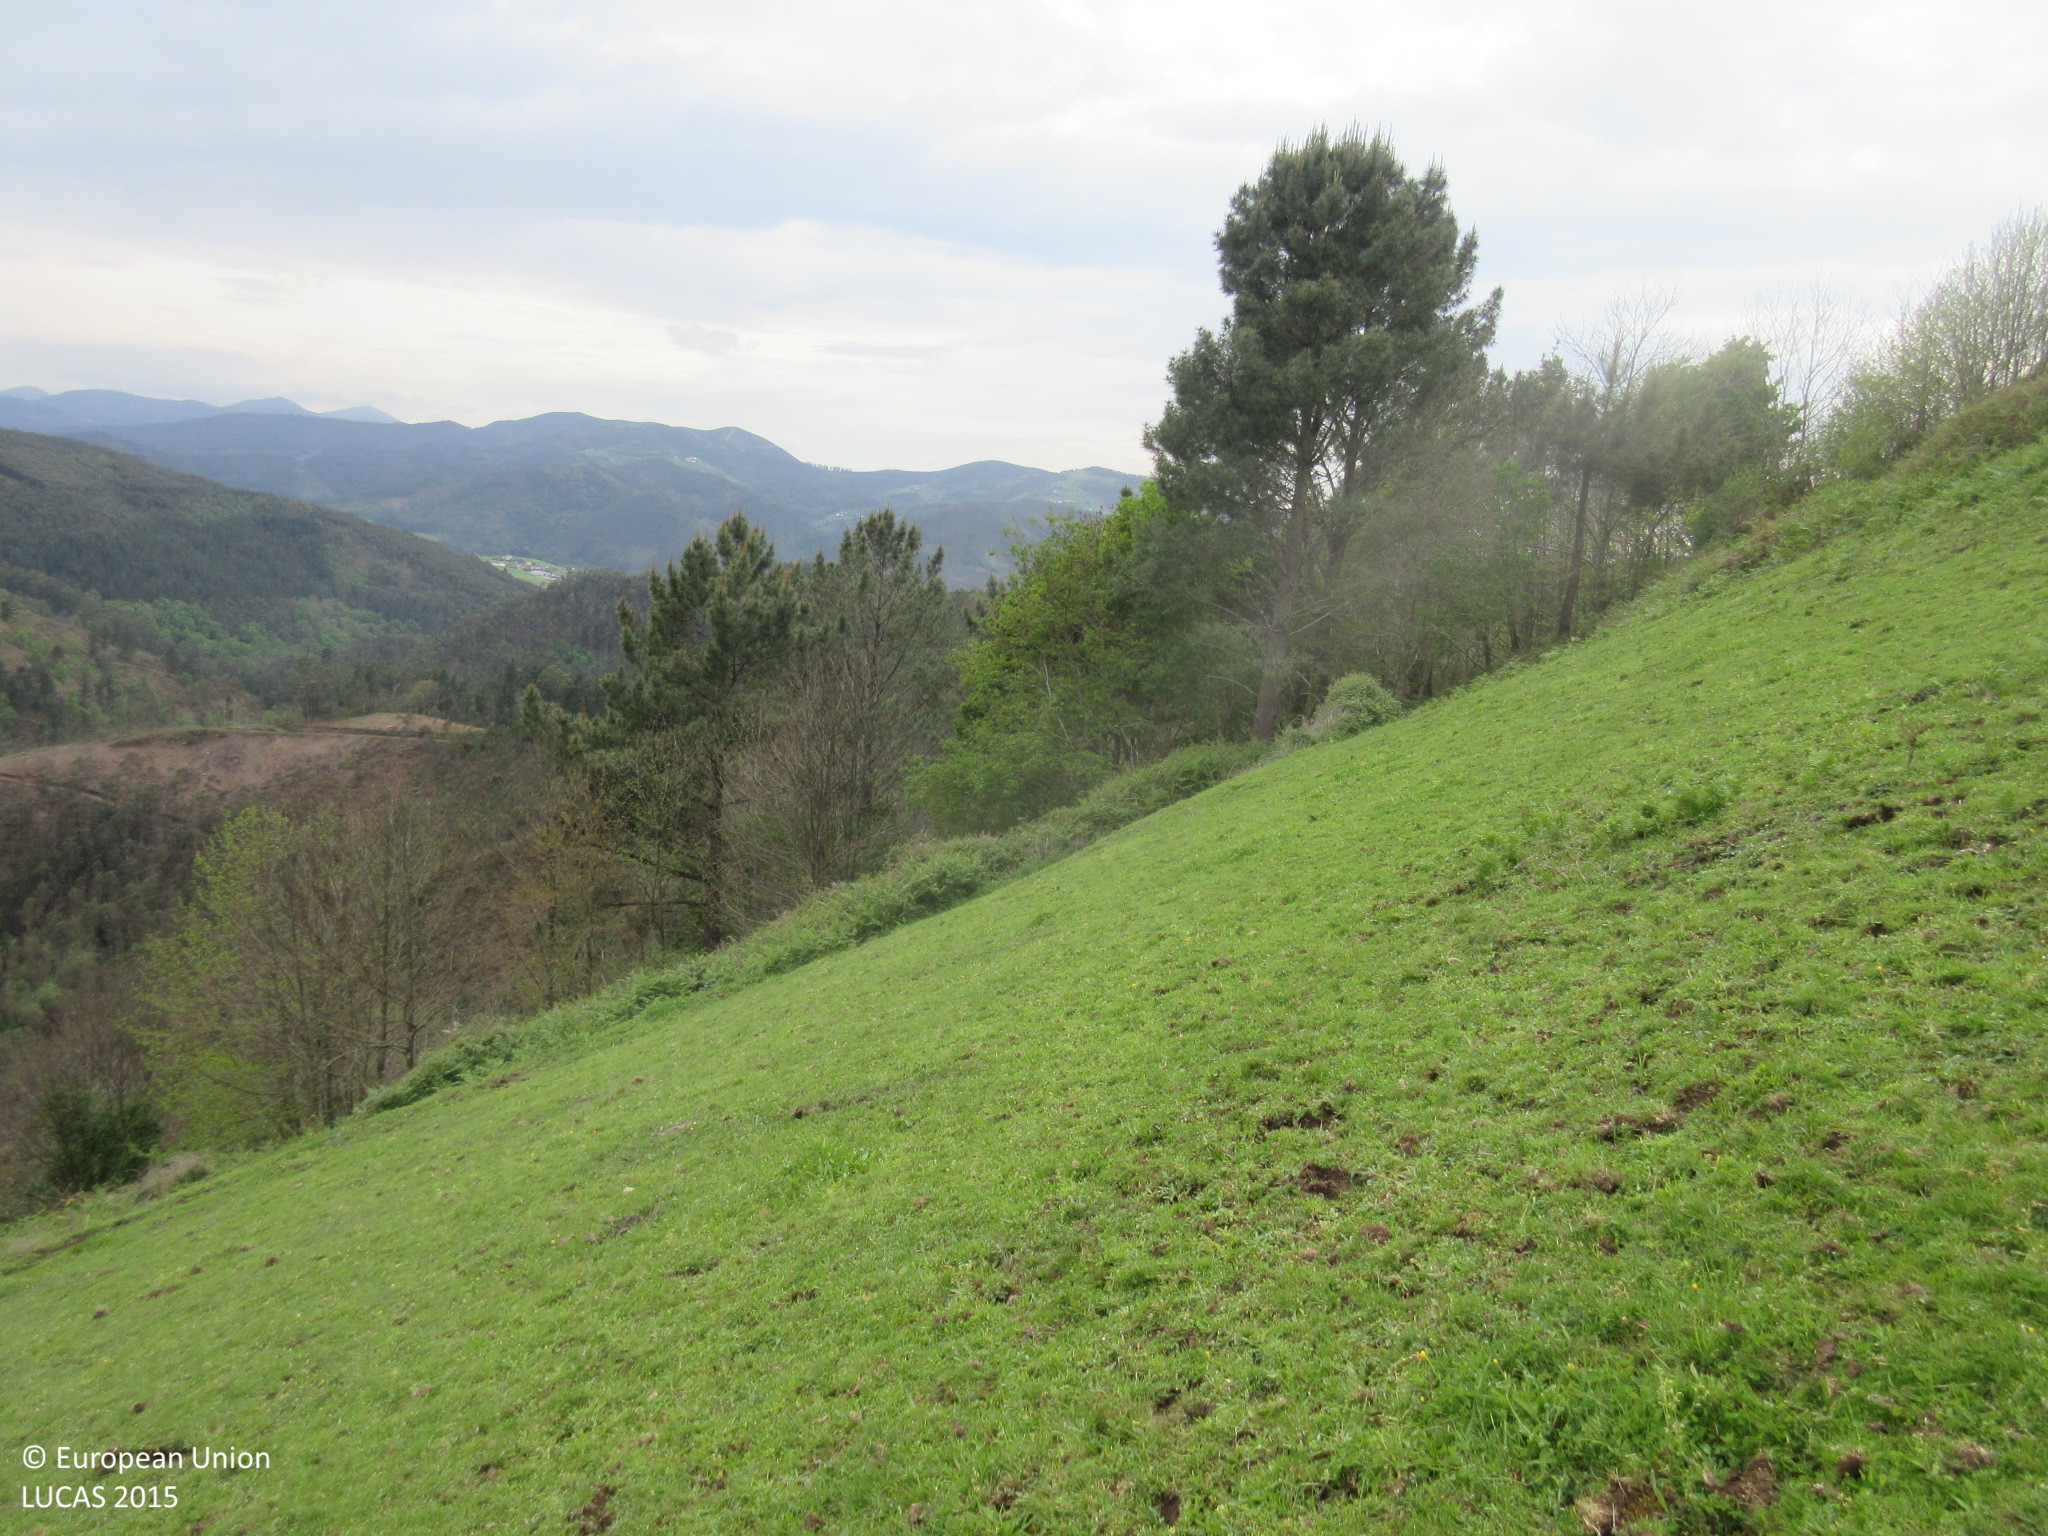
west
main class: Grassland
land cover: Grassland without tree/shrub cover
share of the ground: > 75 %
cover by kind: herbaceous plants 100 %
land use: Agriculture (excluding fallow land and kitchen gardens)
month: April
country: ES
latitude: 43.5138
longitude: -6.3939
